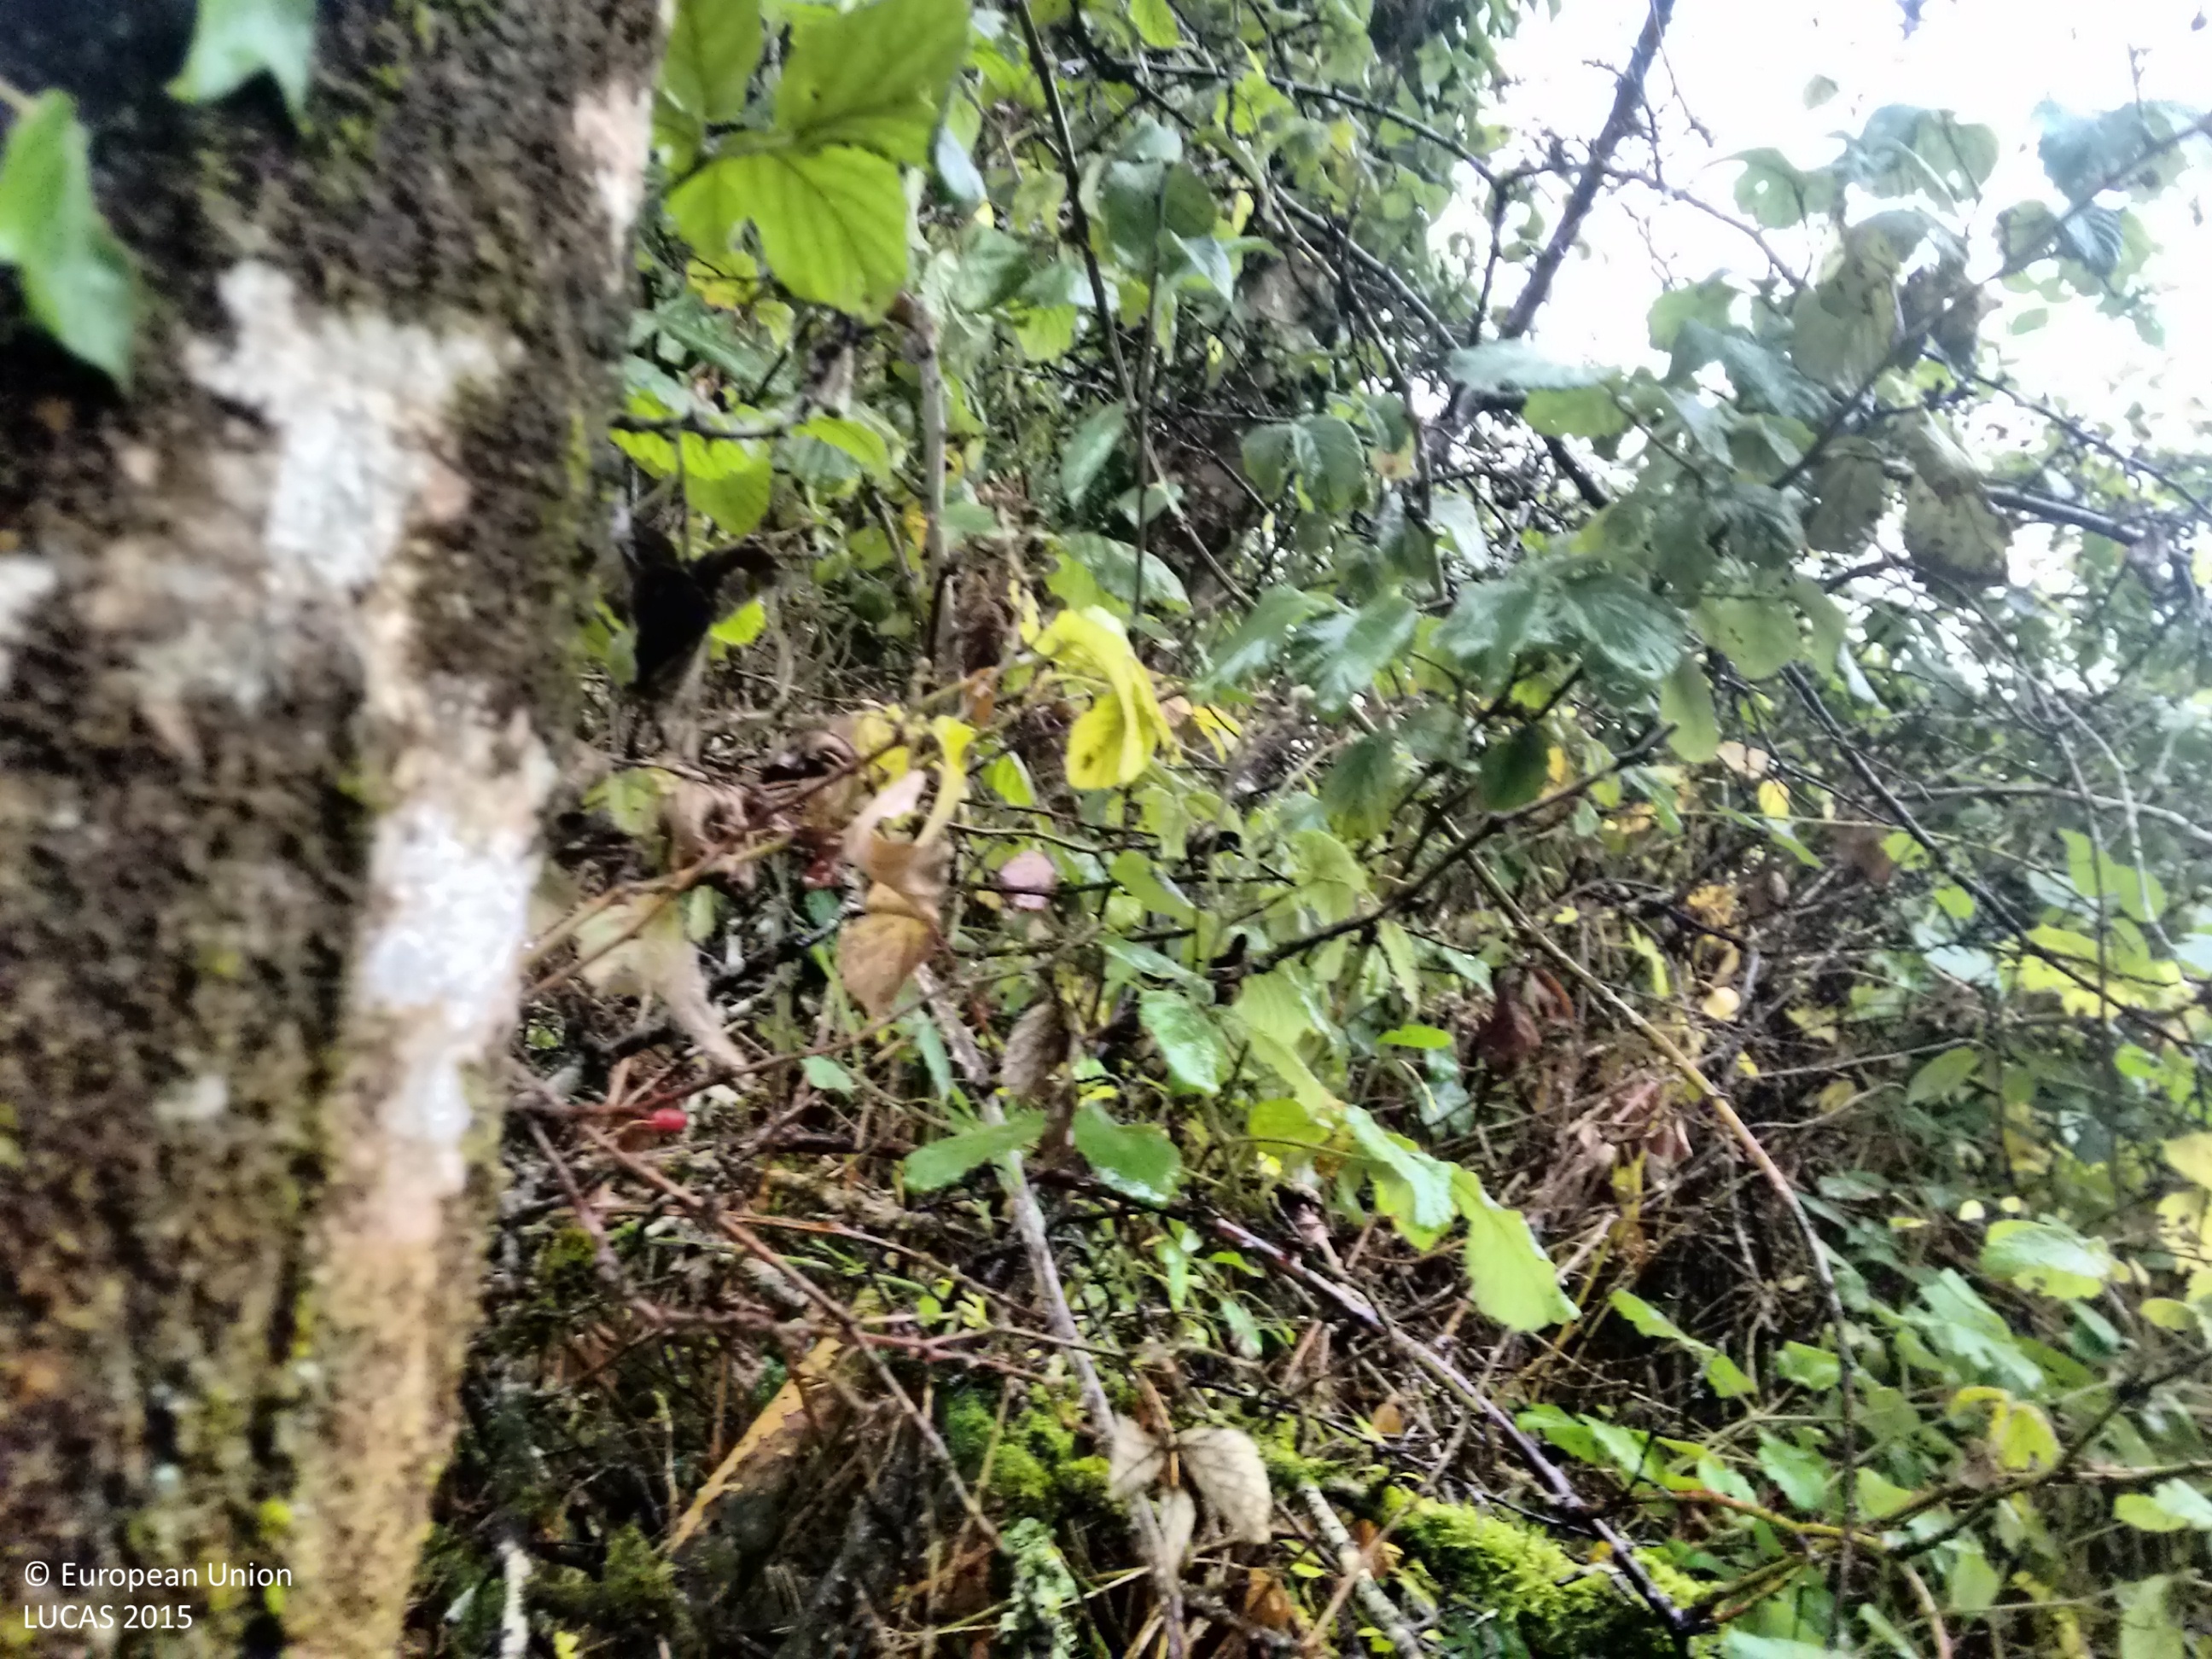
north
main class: Grassland
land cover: Grassland without tree/shrub cover
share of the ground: > 75 %
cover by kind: herbaceous plants 100 %
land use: Agriculture (excluding fallow land and kitchen gardens)
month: October
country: IE
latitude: 53.8704
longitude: -8.0775
